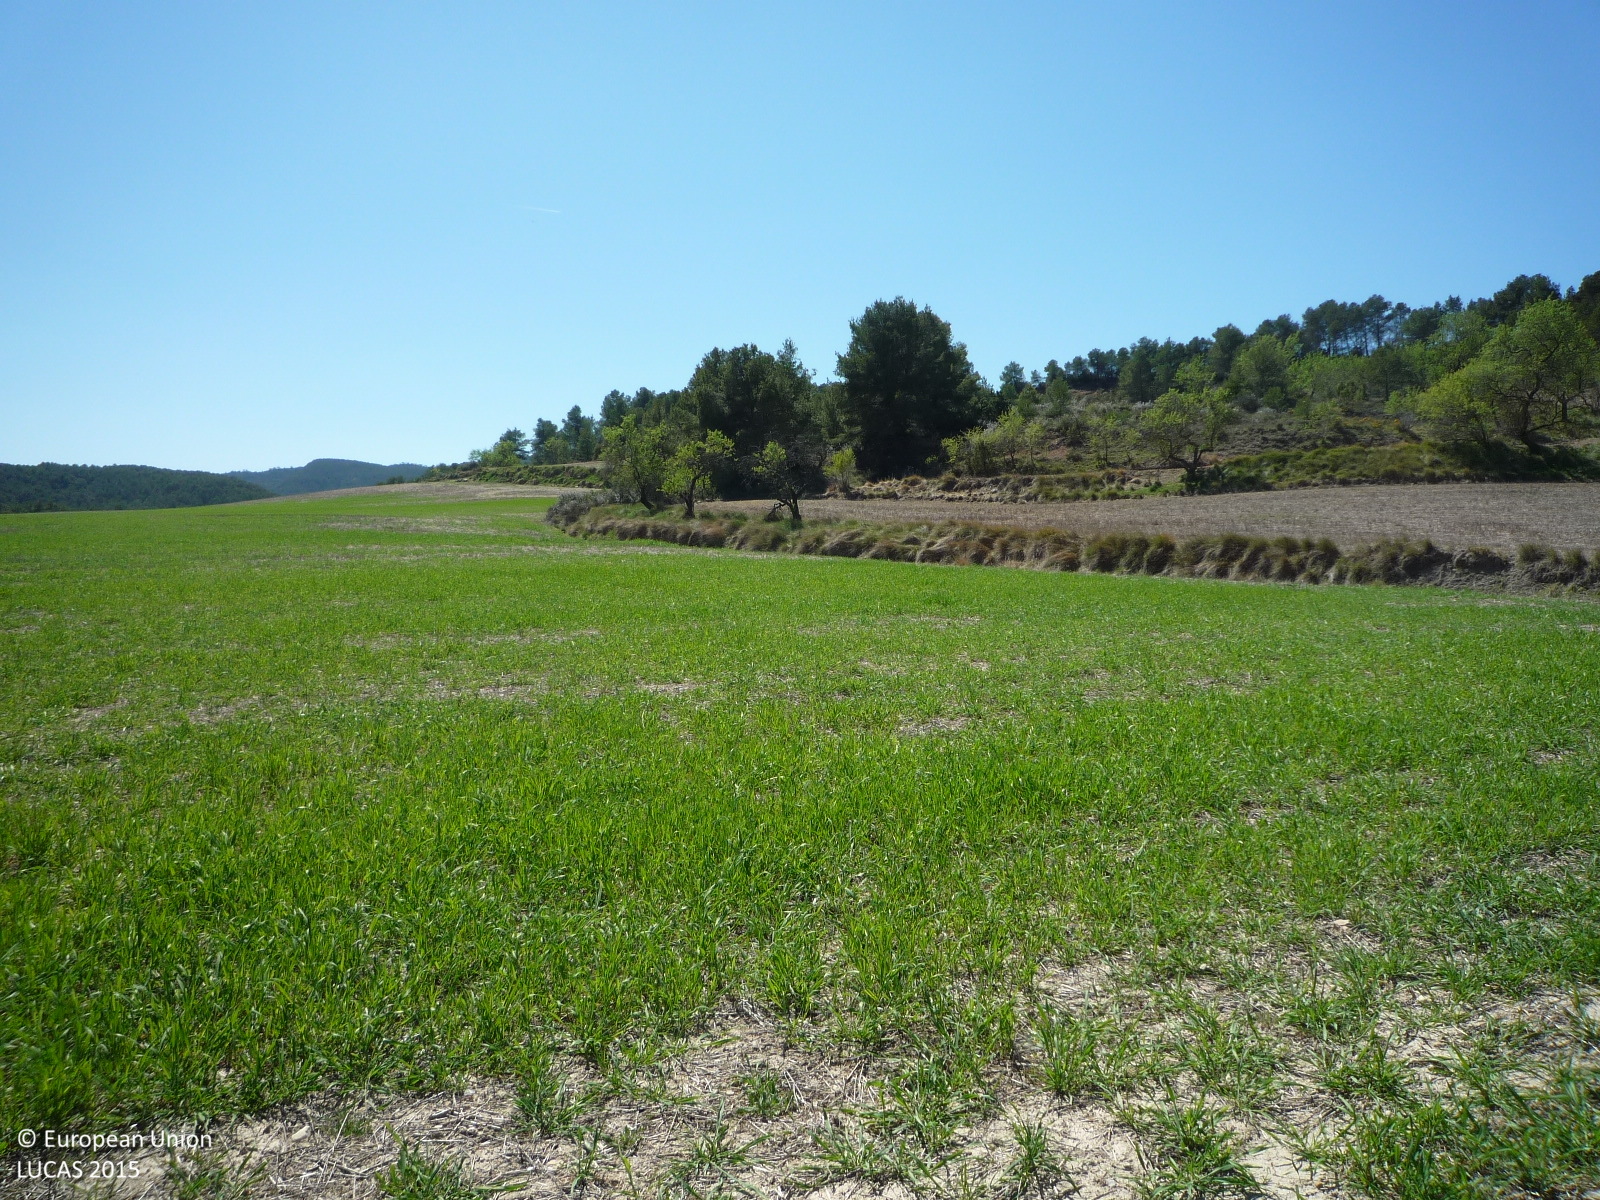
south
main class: Grassland
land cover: Spontaneously vegetated surfaces
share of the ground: > 75 %
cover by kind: herbaceous plants 85 %, unconsolidated bare surface 15 %
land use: Agriculture (excluding fallow land and kitchen gardens)
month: April
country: ES
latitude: 41.5510
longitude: 1.4913
